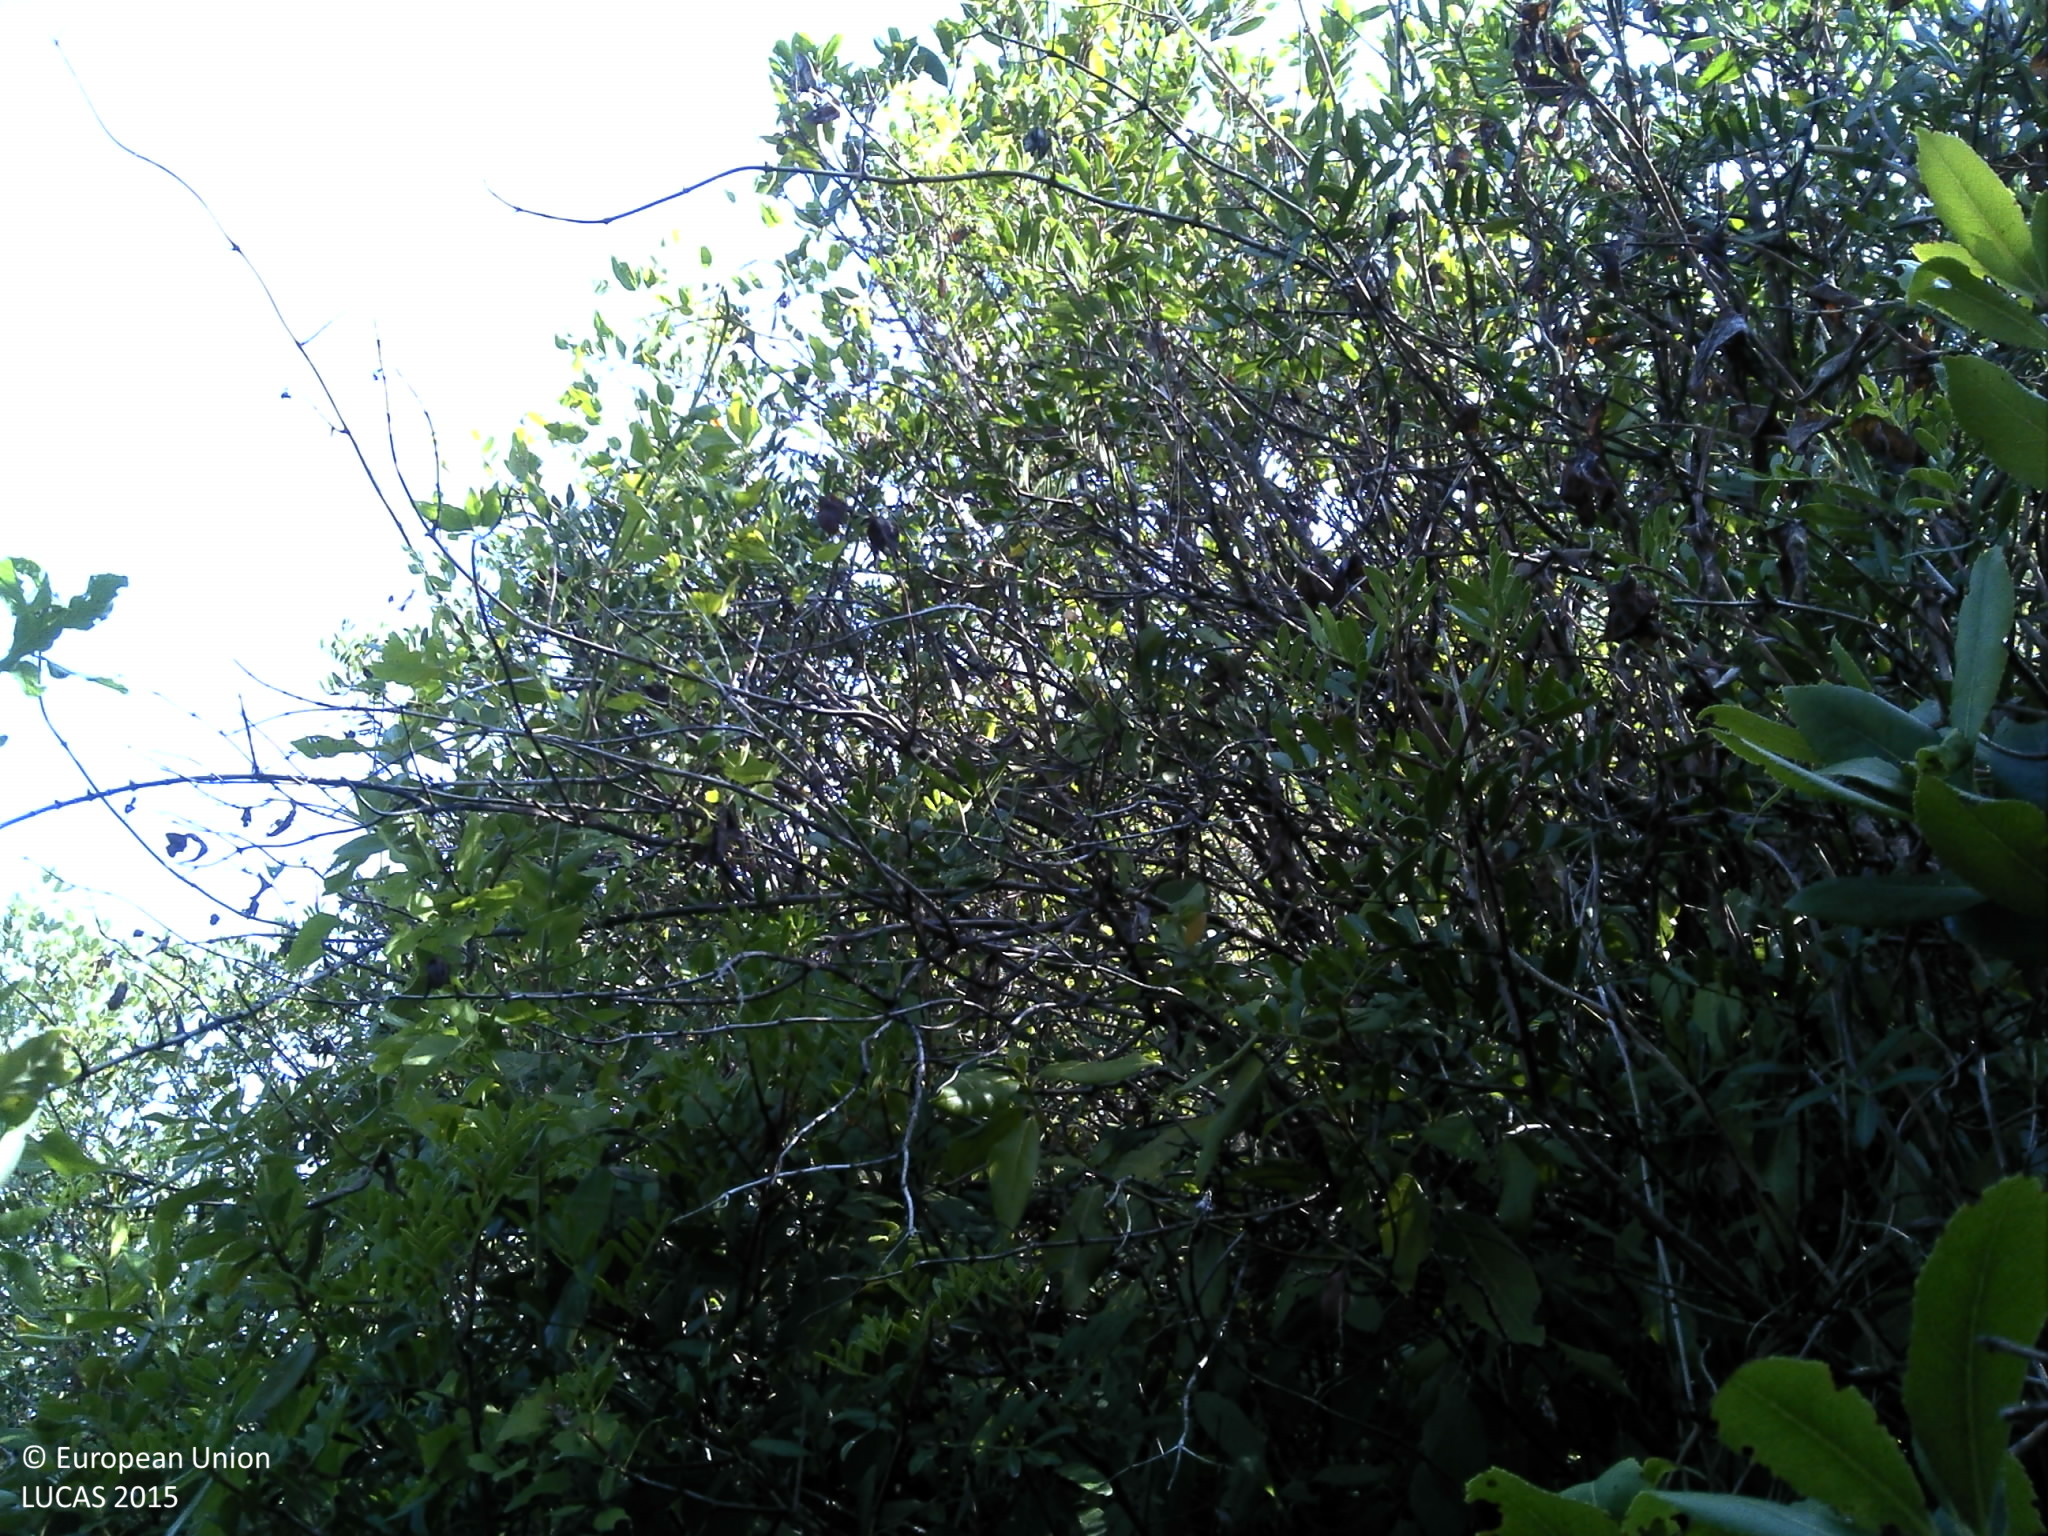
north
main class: Woodland
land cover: Other mixed woodland
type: coniferous forest of the mediterranean region
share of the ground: 25 - 50 %
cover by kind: shrubs 40 %, coniferous forest trees 30 %, broadleaved forest trees 20 %, unconsolidated bare surface 10 %
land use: Semi-natural and natural areas not in use
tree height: > 5 m
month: August
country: HR
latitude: 42.9296
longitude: 17.1081
